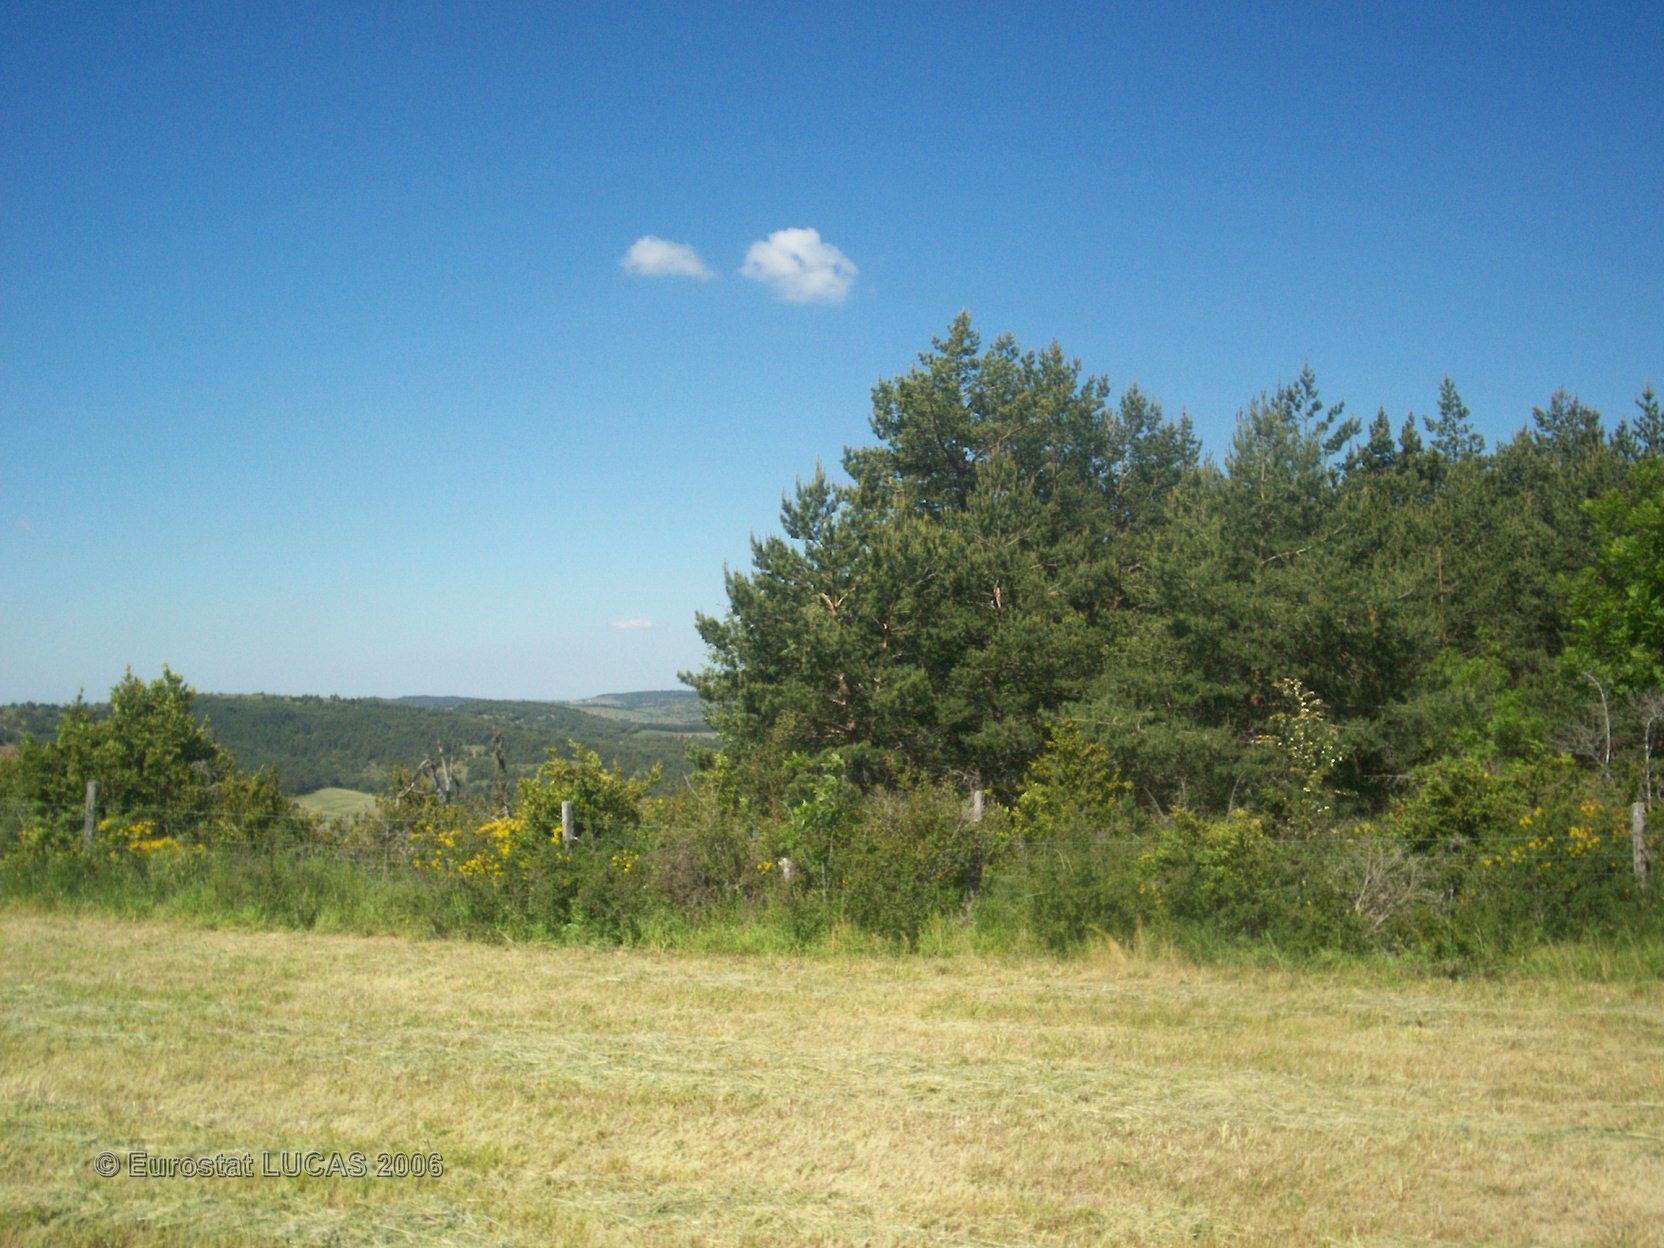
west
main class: Cropland
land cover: Other leguminous and mixtures for fodder
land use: Agriculture (excluding fallow land and kitchen gardens)
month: June
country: FR
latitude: 44.1775
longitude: 3.4145
